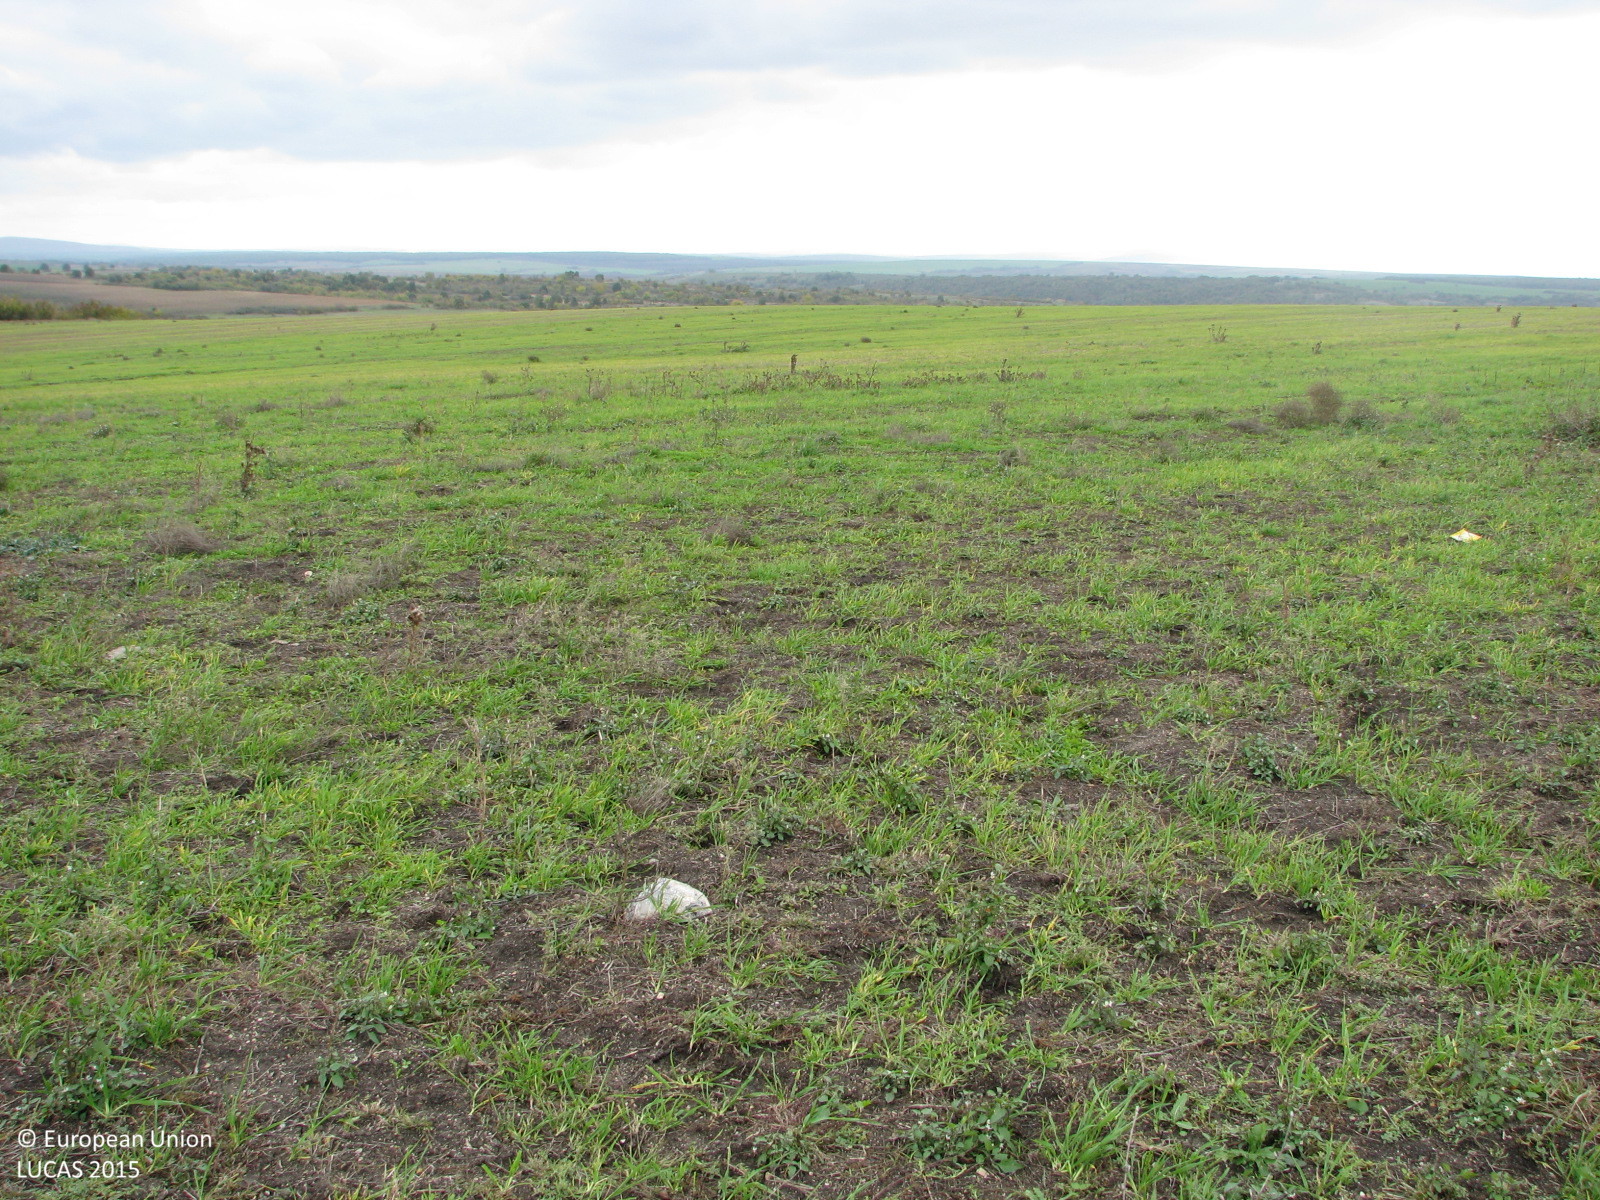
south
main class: Grassland
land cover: Spontaneously vegetated surfaces
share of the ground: > 75 %
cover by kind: herbaceous plants 80 %, unconsolidated bare surface 20 %
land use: Agriculture (excluding fallow land and kitchen gardens)
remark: Harvested field
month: October
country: BG
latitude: 42.2224
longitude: 26.7530
